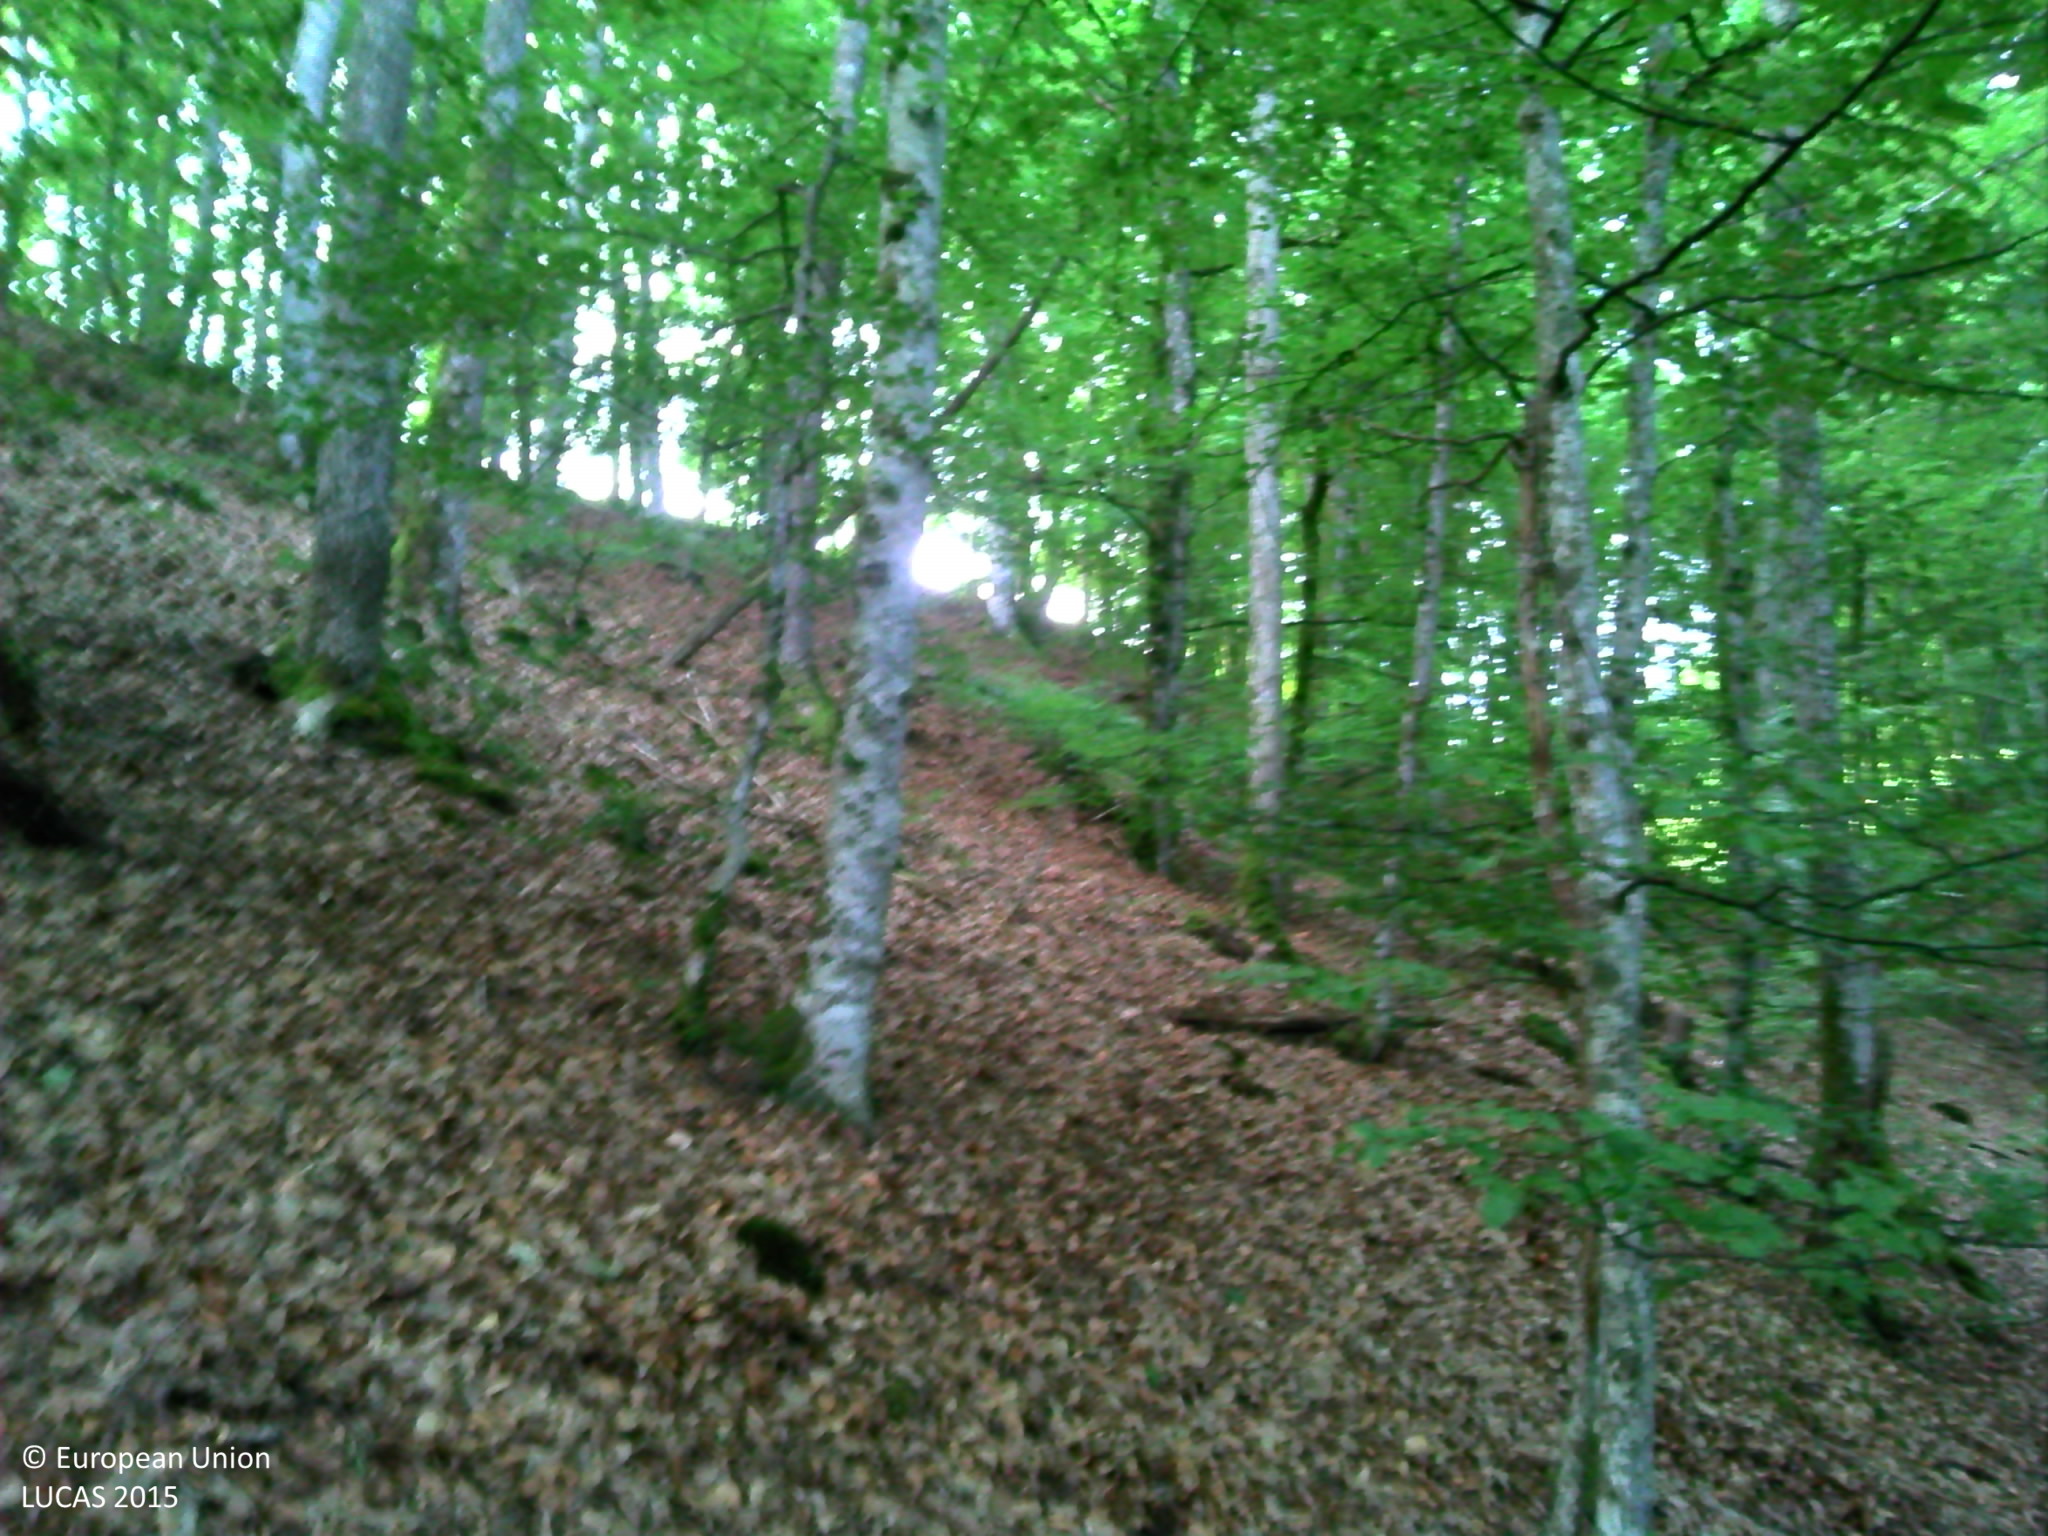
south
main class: Woodland
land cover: Broadleaved woodland
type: acidophilous oak and oak-birch forest
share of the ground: > 75 %
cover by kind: broadleaved forest trees 90 %, herbaceous plants 5 %, lichens and mosses 5 %
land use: Forestry
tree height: > 5 m
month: June
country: FR
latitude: 44.9033
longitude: 2.8974
